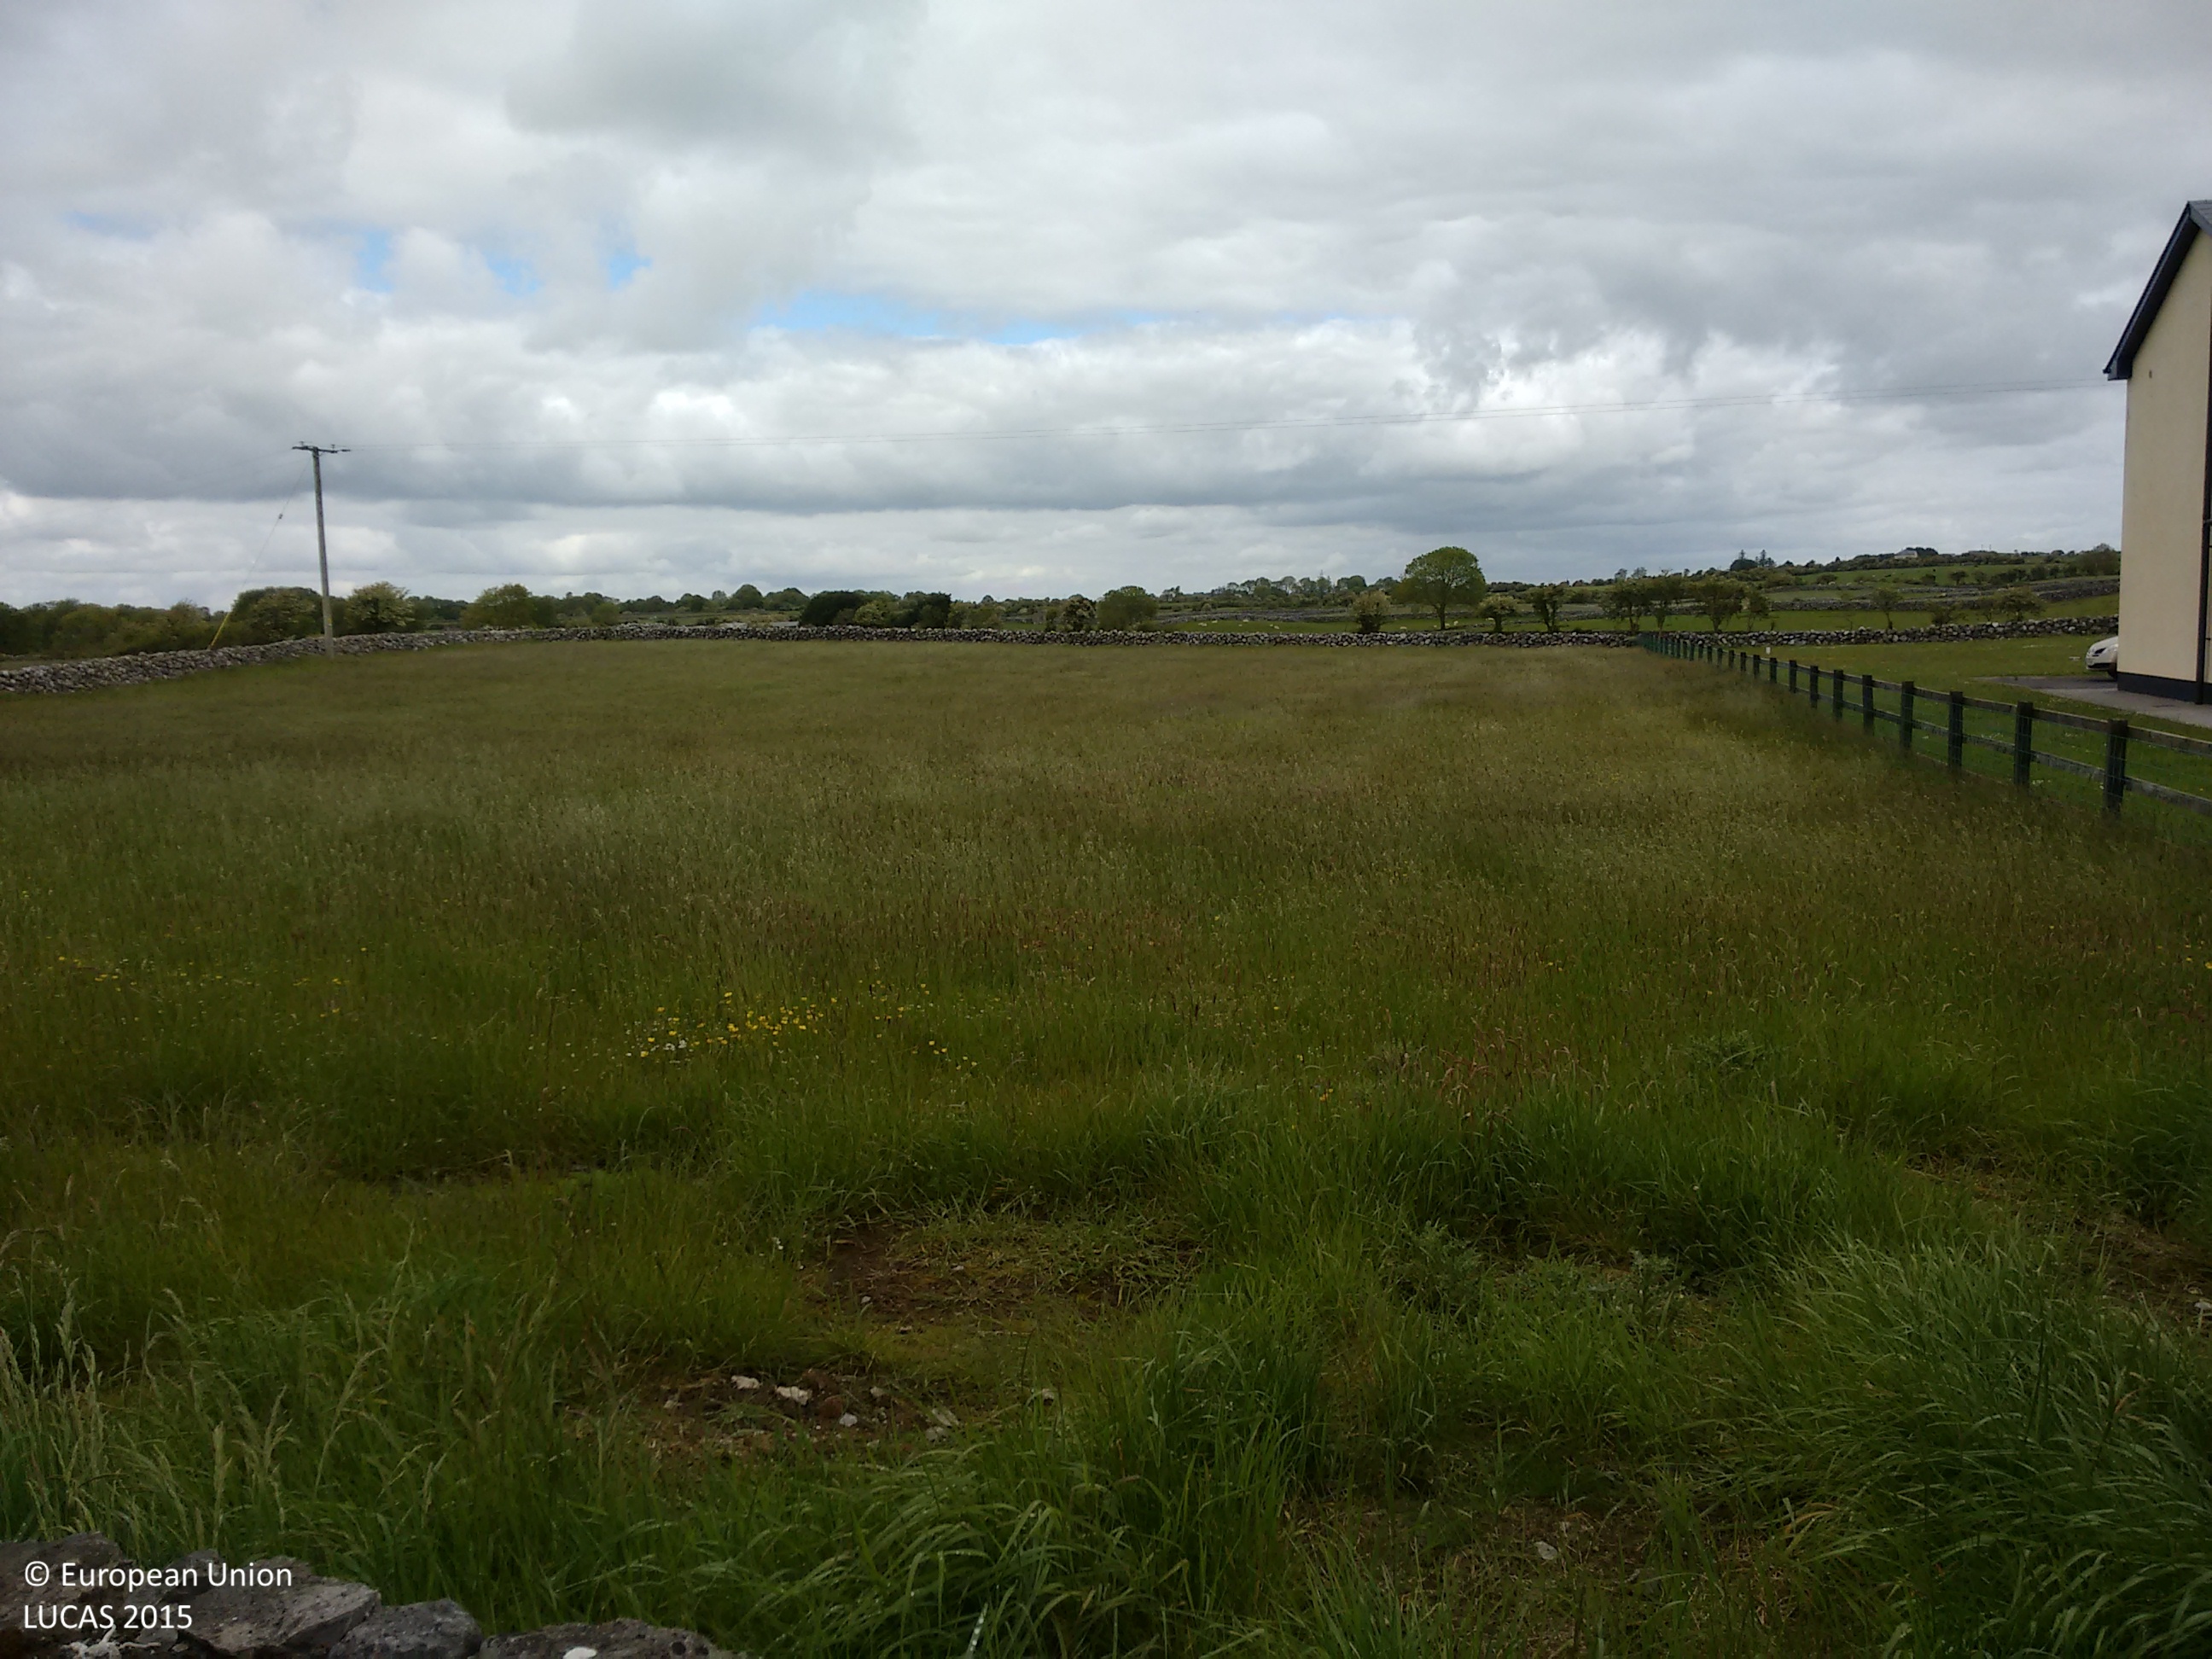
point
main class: Grassland
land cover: Grassland without tree/shrub cover
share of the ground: > 75 %
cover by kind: herbaceous plants 100 %
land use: Agriculture (excluding fallow land and kitchen gardens)
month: June
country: IE
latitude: 53.4594
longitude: -9.0560
